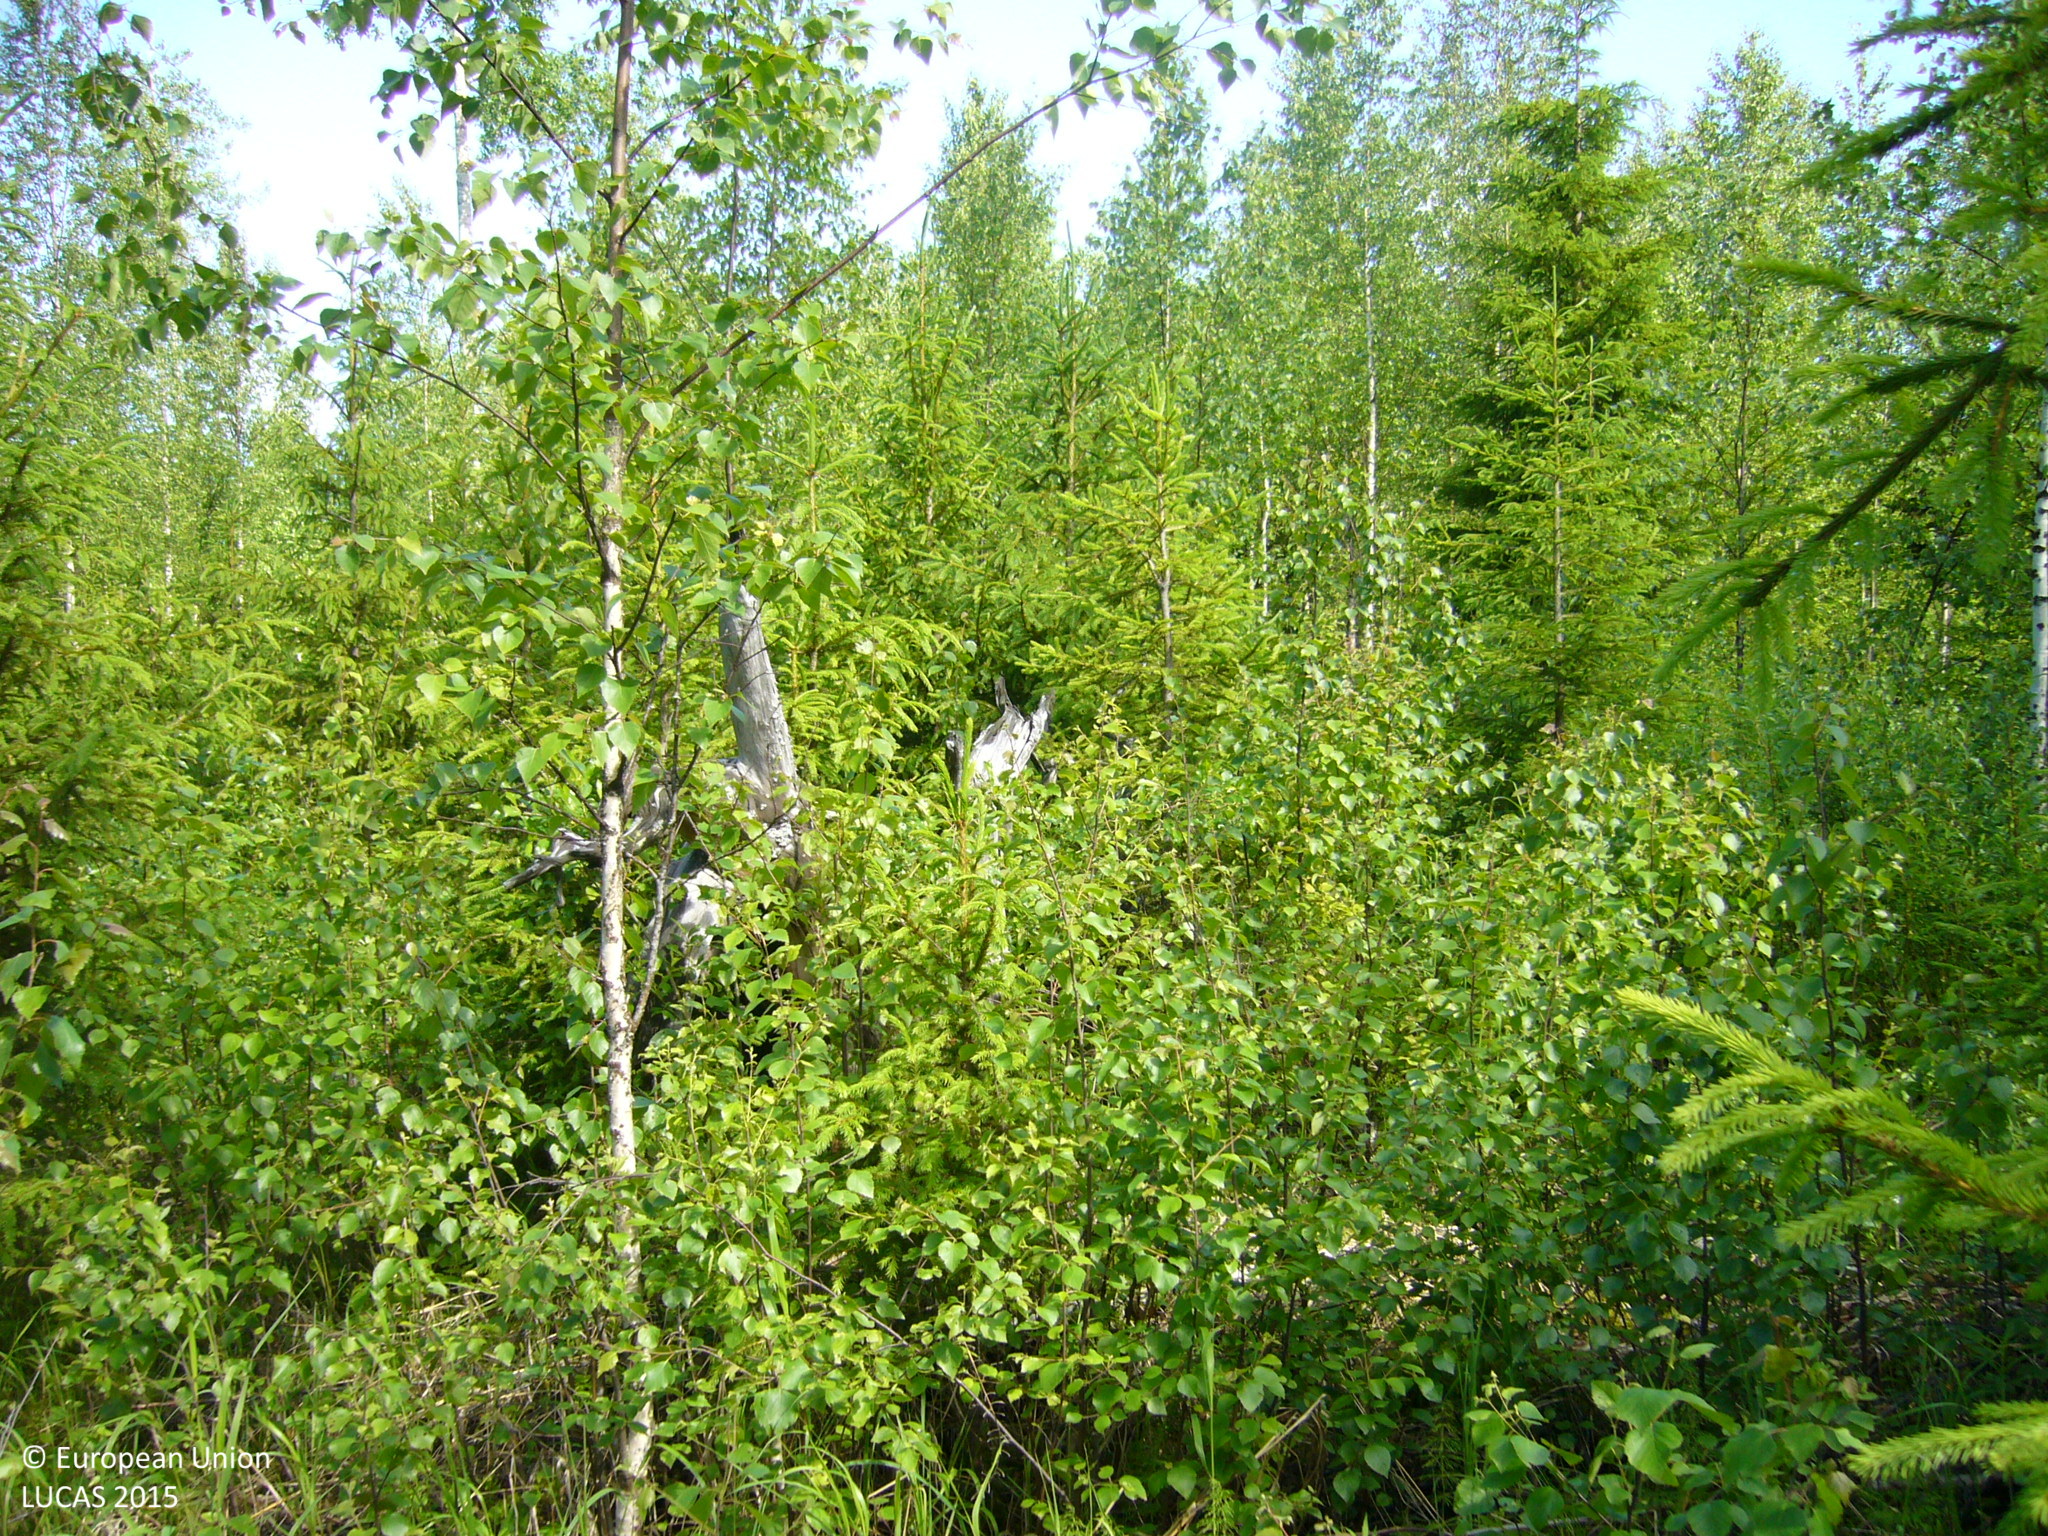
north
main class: Woodland
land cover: Spruce dominated mixed woodland
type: boreal forest
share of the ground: > 75 %
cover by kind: broadleaved forest trees 45 %, coniferous forest trees 40 %, shrubs 15 %
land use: Forestry
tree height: < 5 m
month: July
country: FI
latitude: 63.5705
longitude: 26.2492
